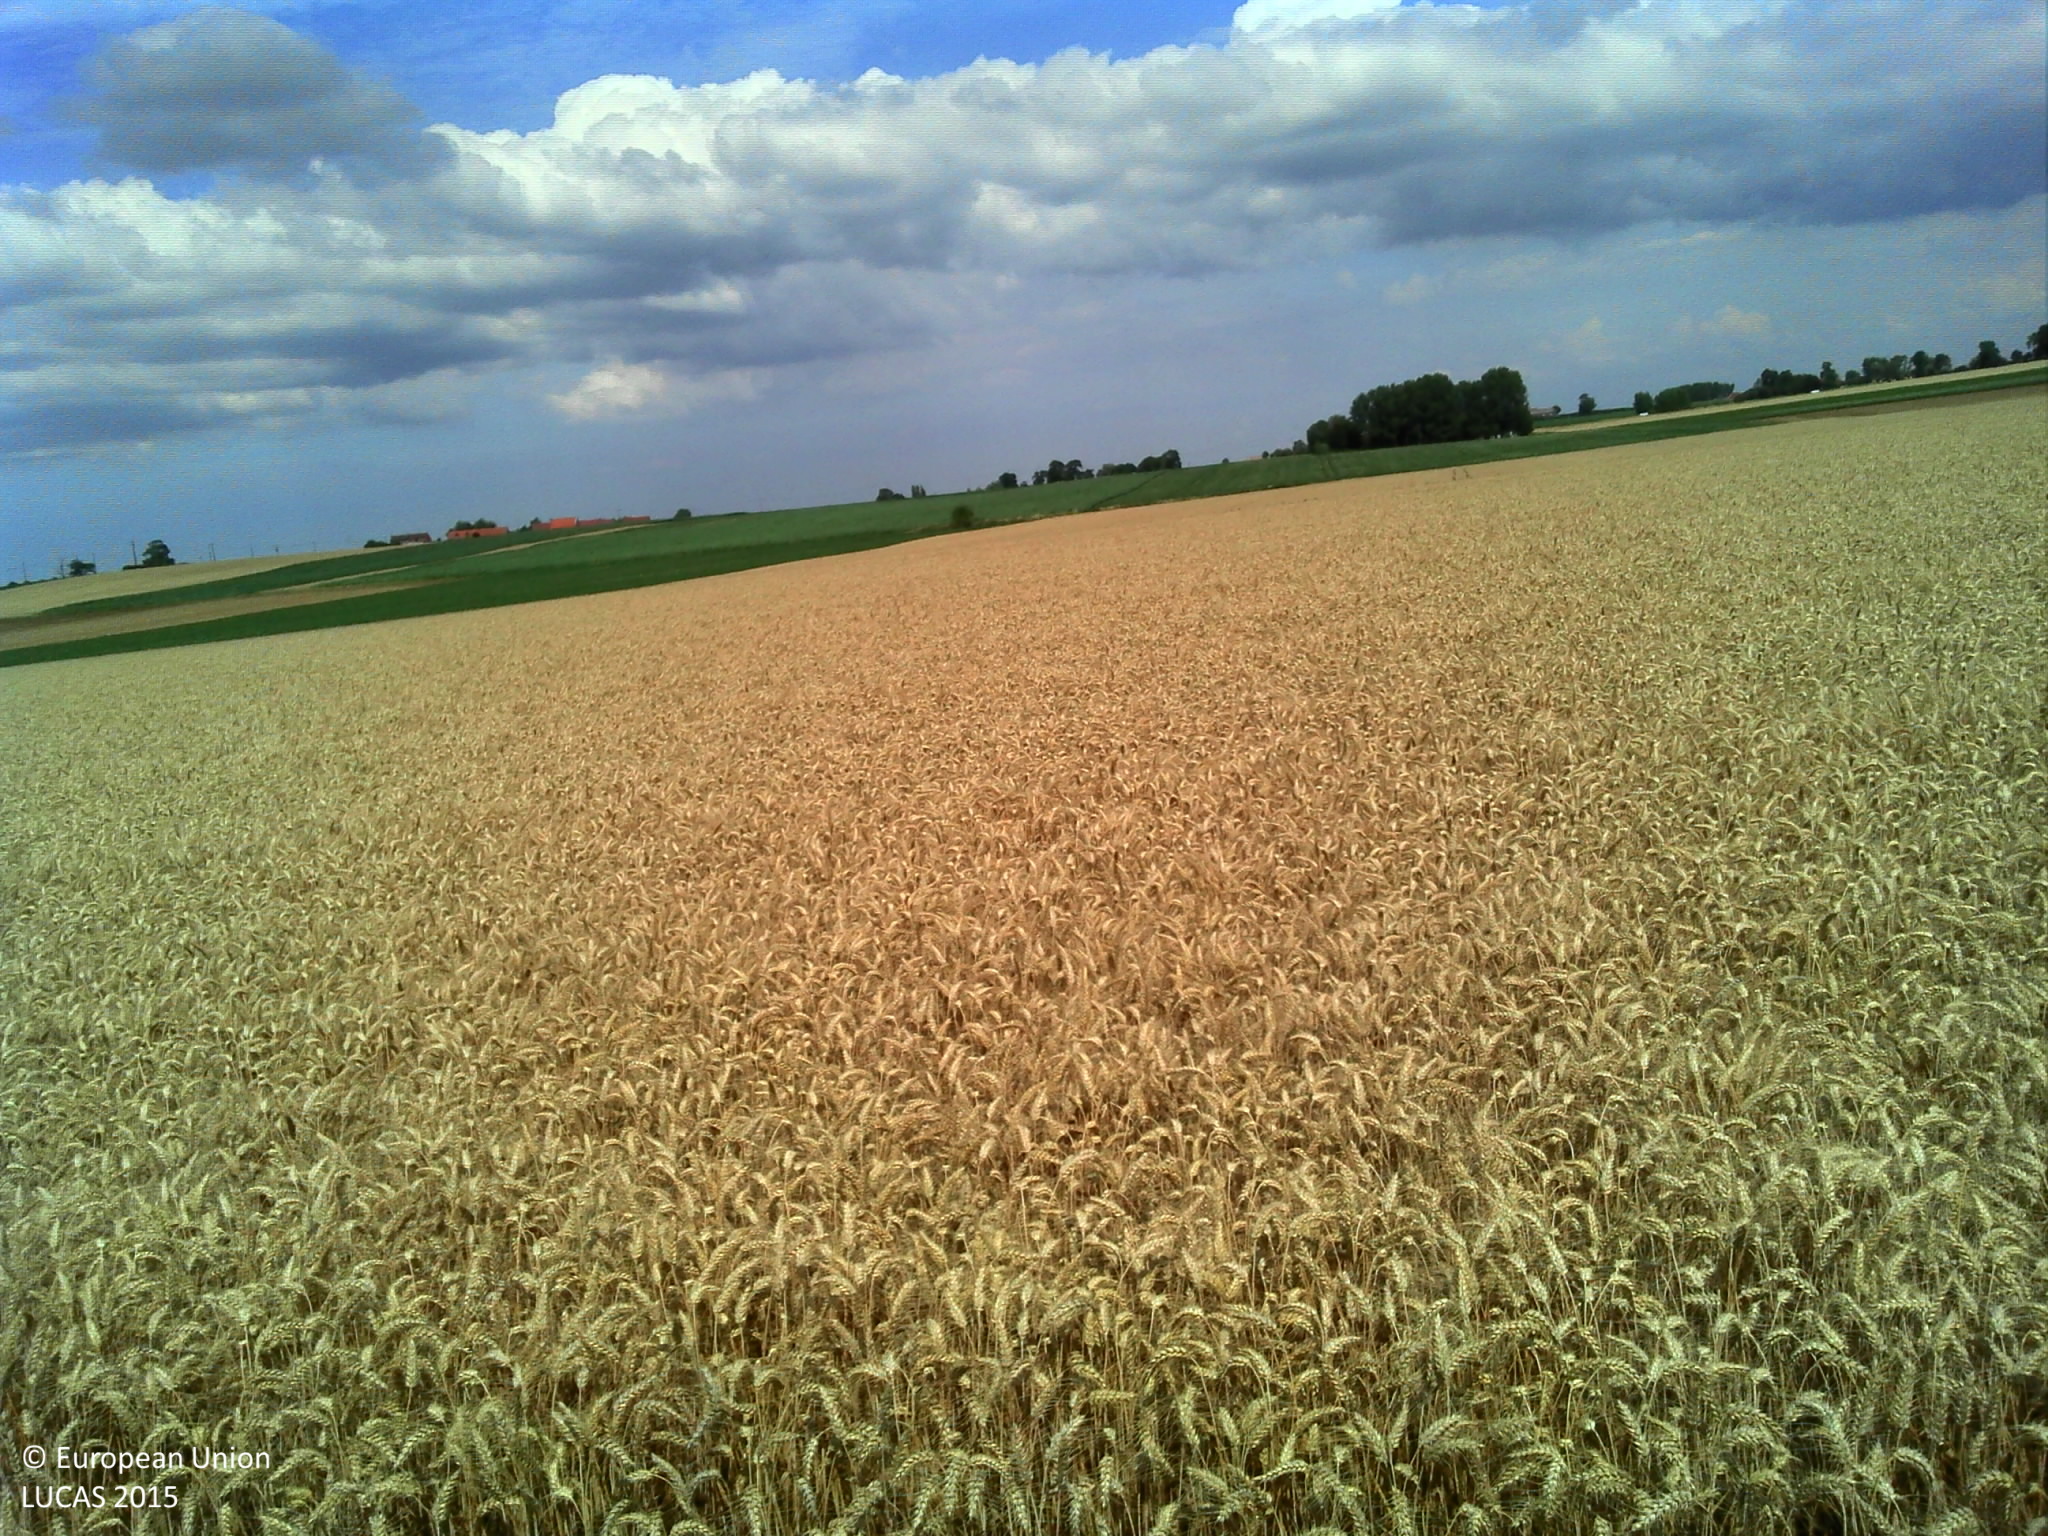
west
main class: Cropland
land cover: Common wheat
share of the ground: > 75 %
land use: Agriculture (excluding fallow land and kitchen gardens)
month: July
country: FR
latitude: 50.8168
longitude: 2.4215
